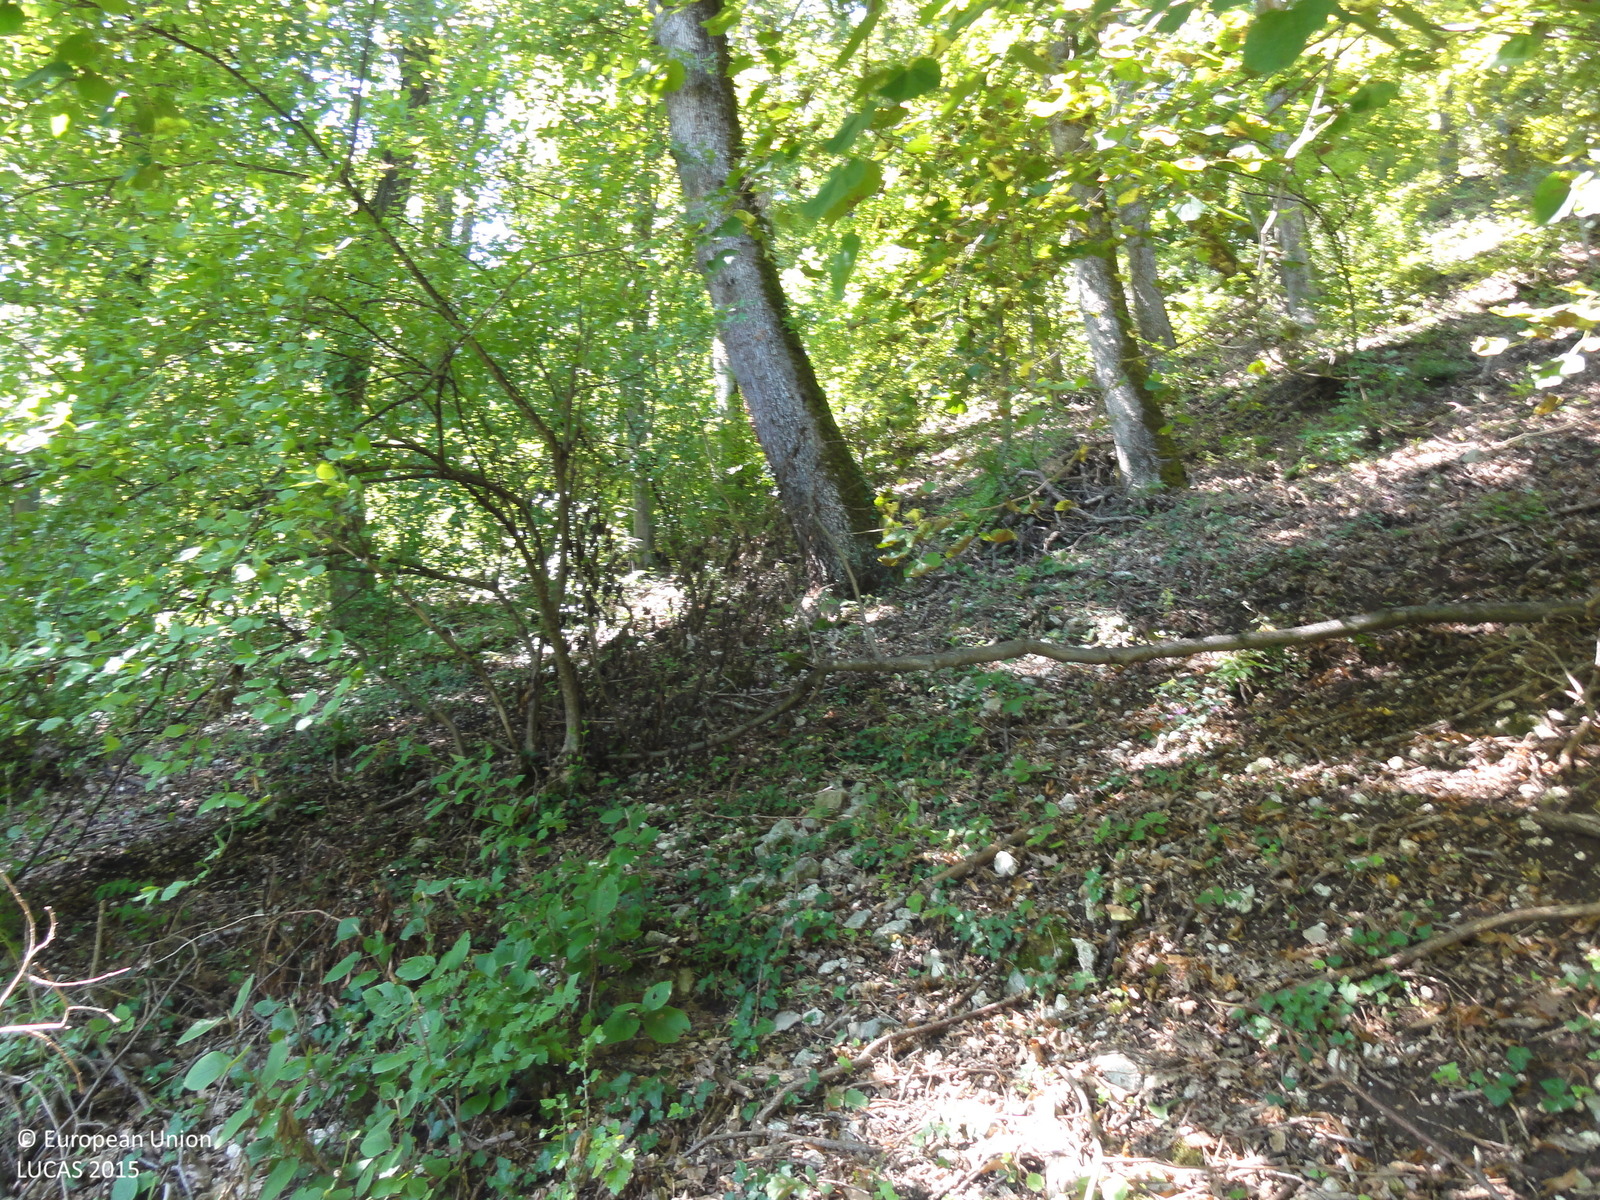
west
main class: Woodland
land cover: Broadleaved woodland
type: mesophytic deciduous forest
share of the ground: > 75 %
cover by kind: broadleaved forest trees 85 %, herbaceous plants 10 %, shrubs 5 %
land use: Forestry
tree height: > 5 m
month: August
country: SI
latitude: 46.0311
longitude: 15.4625
